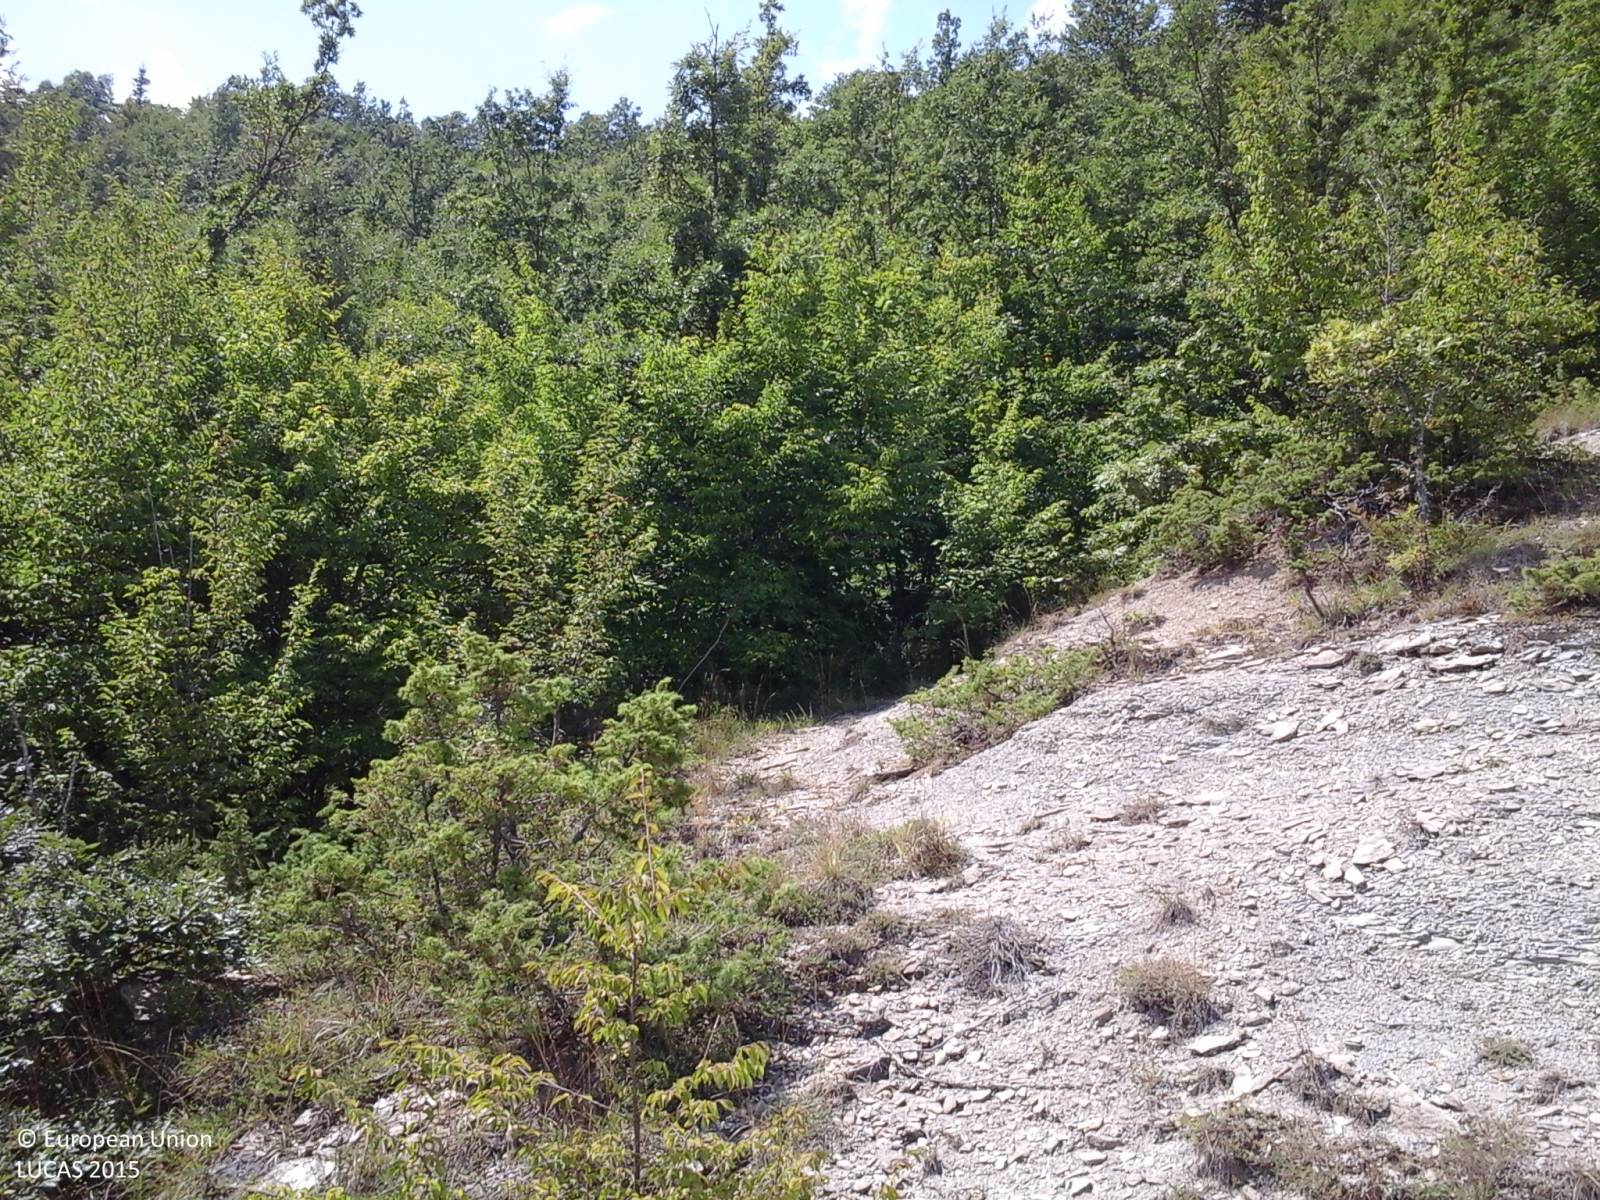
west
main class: Grassland
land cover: Grassland without tree/shrub cover
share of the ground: > 75 %
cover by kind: herbaceous plants 100 %
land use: Agriculture (excluding fallow land and kitchen gardens)
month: August
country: IT
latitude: 43.6969
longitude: 12.1411
